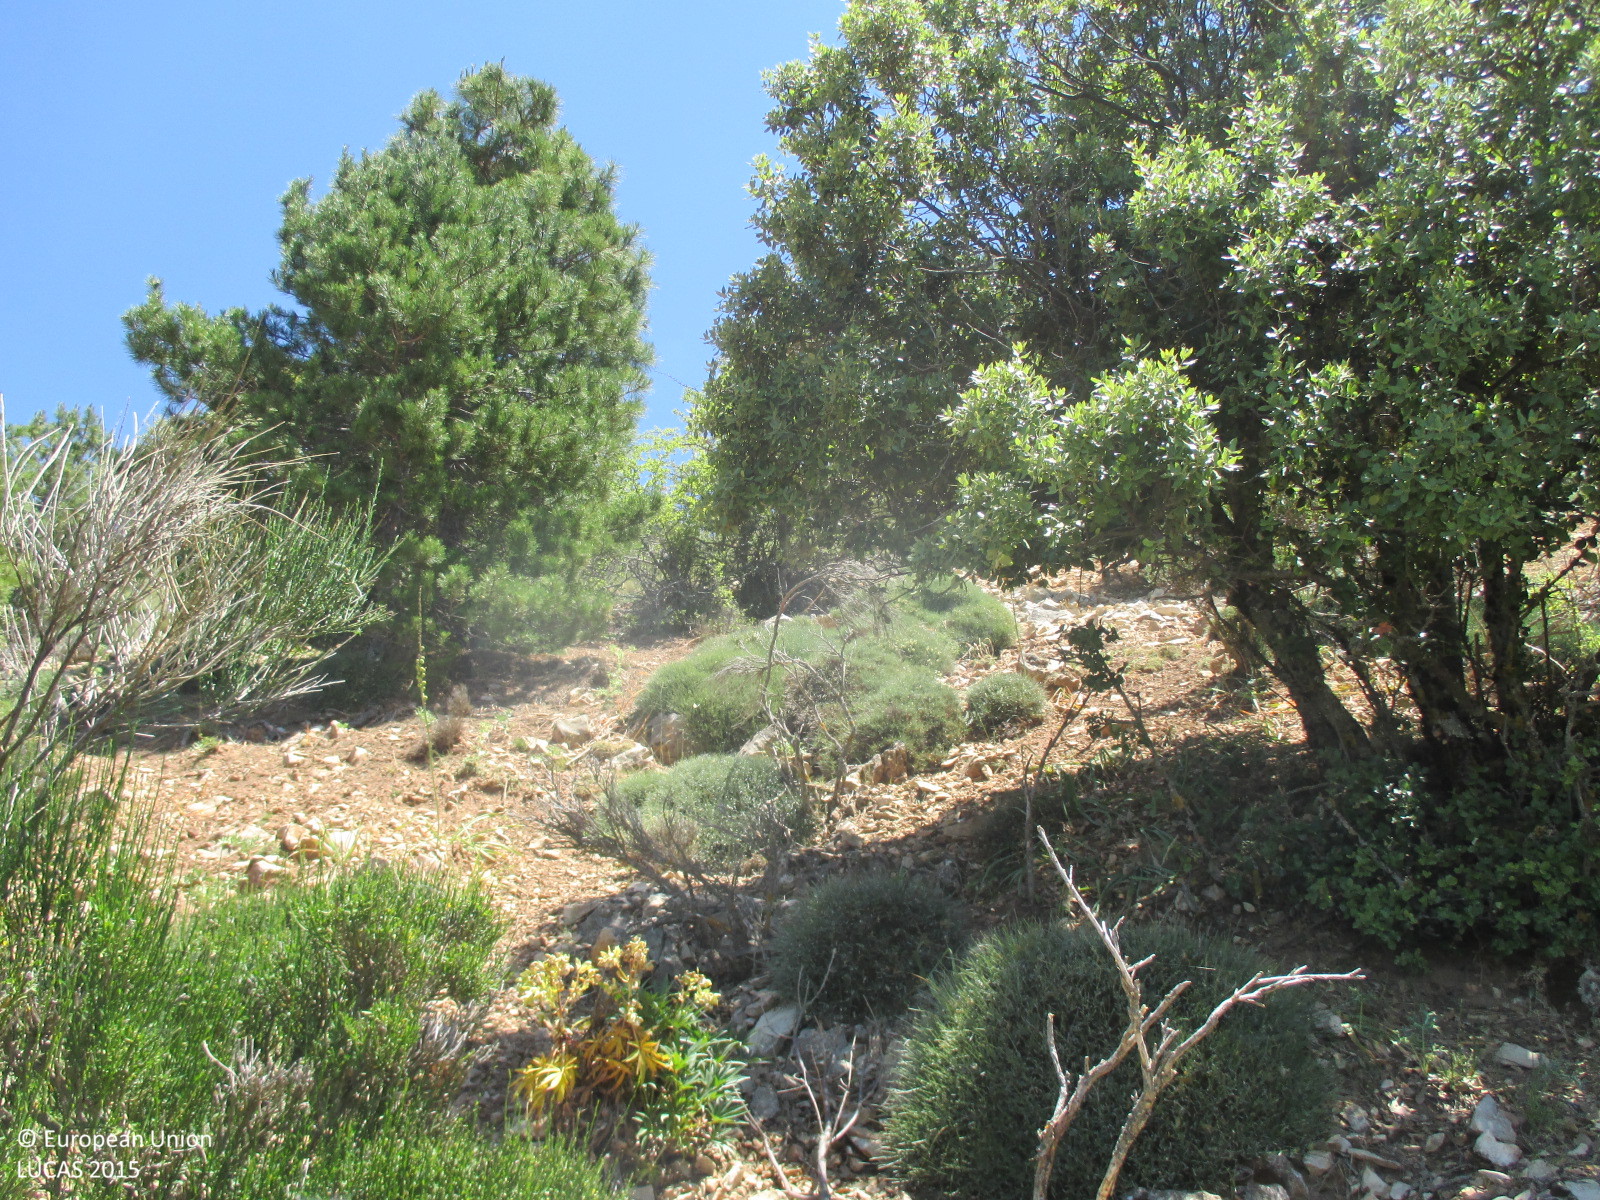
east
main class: Woodland
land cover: Pine dominated coniferous woodland
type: coniferous forest of the mediterranean region
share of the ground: 25 - 50 %
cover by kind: coniferous forest trees 30 %, herbaceous plants 30 %, shrubs 20 %, consolidated bare surface 10 %, unconsolidated bare surface 10 %
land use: Forestry
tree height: > 5 m
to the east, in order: Pine dominated coniferous woodland; Shrubland with sparse tree cover; Shrubland without tree cover; Shrubland with sparse tree cover; Pine dominated coniferous woodland
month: June
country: ES
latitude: 37.5160
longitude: -3.7425
